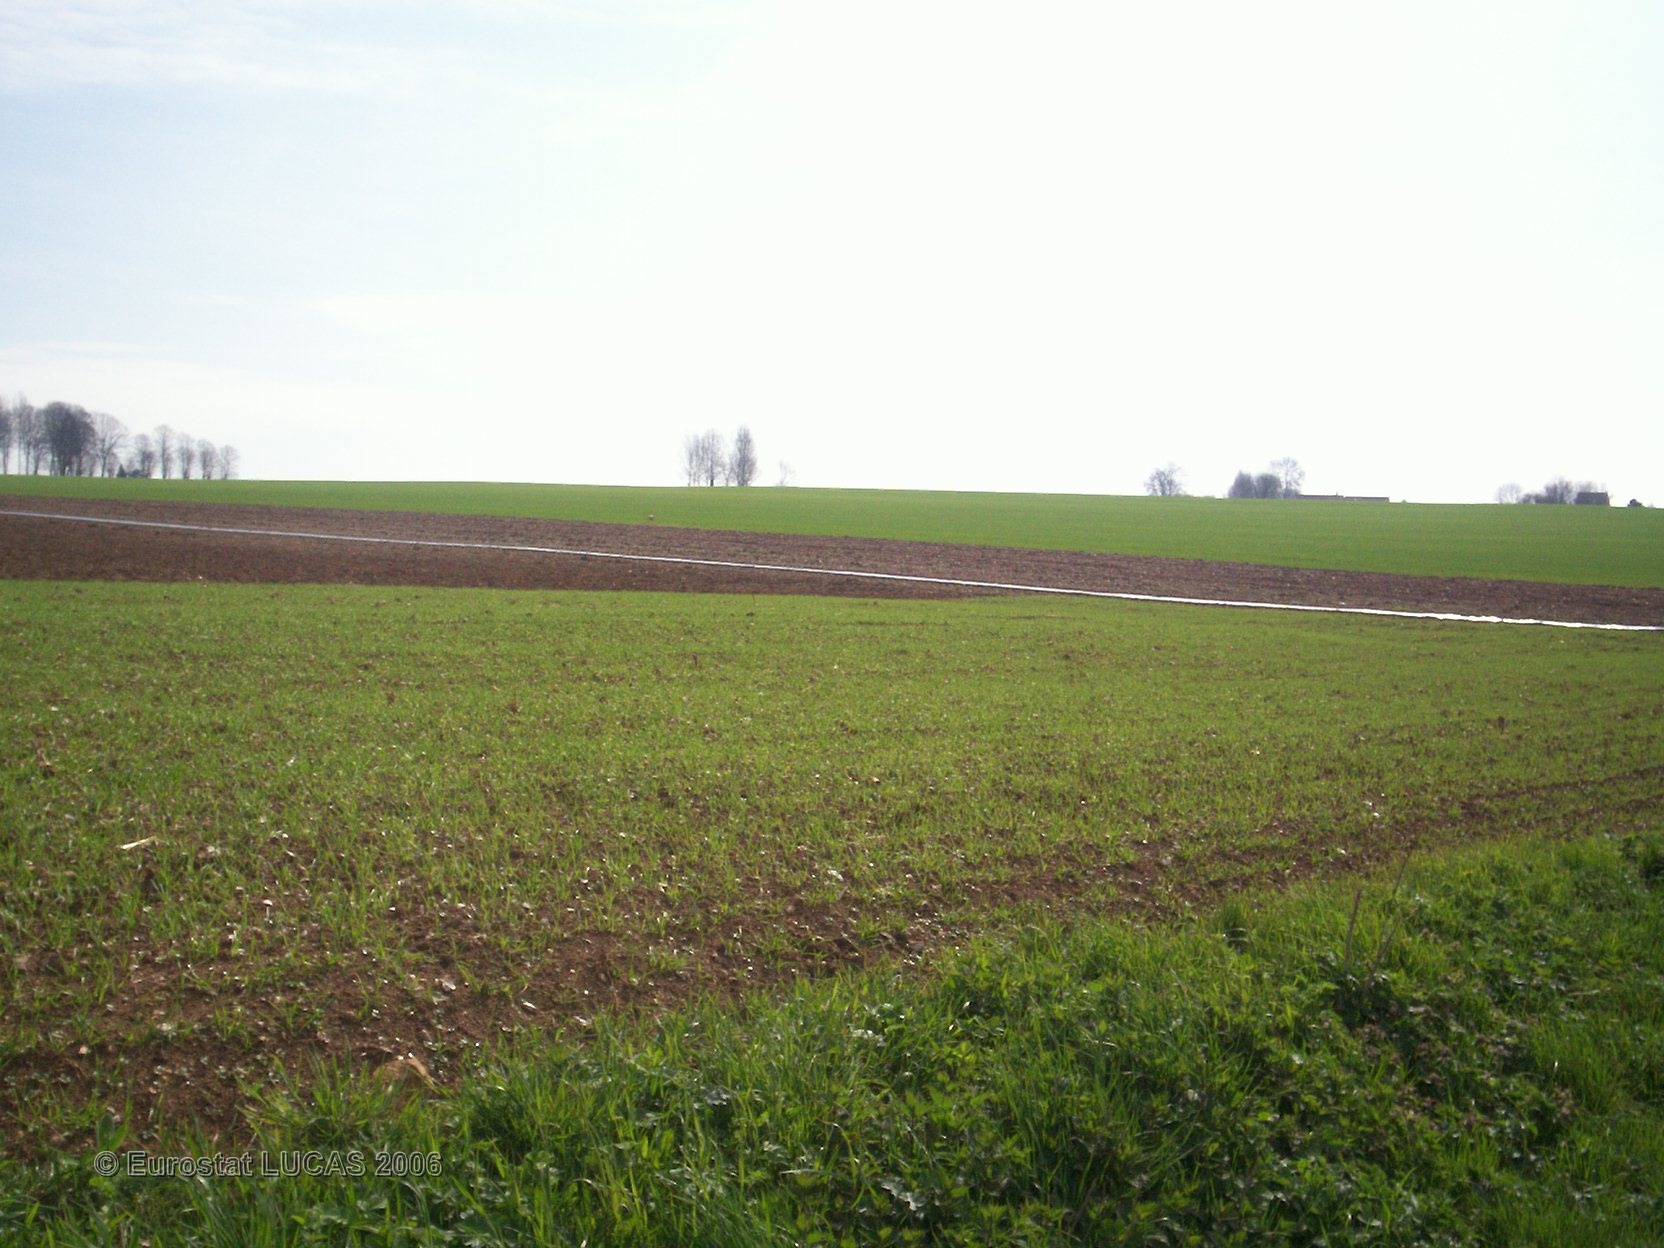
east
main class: Cropland
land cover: Common wheat
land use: Agriculture (excluding fallow land and kitchen gardens)
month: April
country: FR
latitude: 50.0574
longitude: 2.6834
